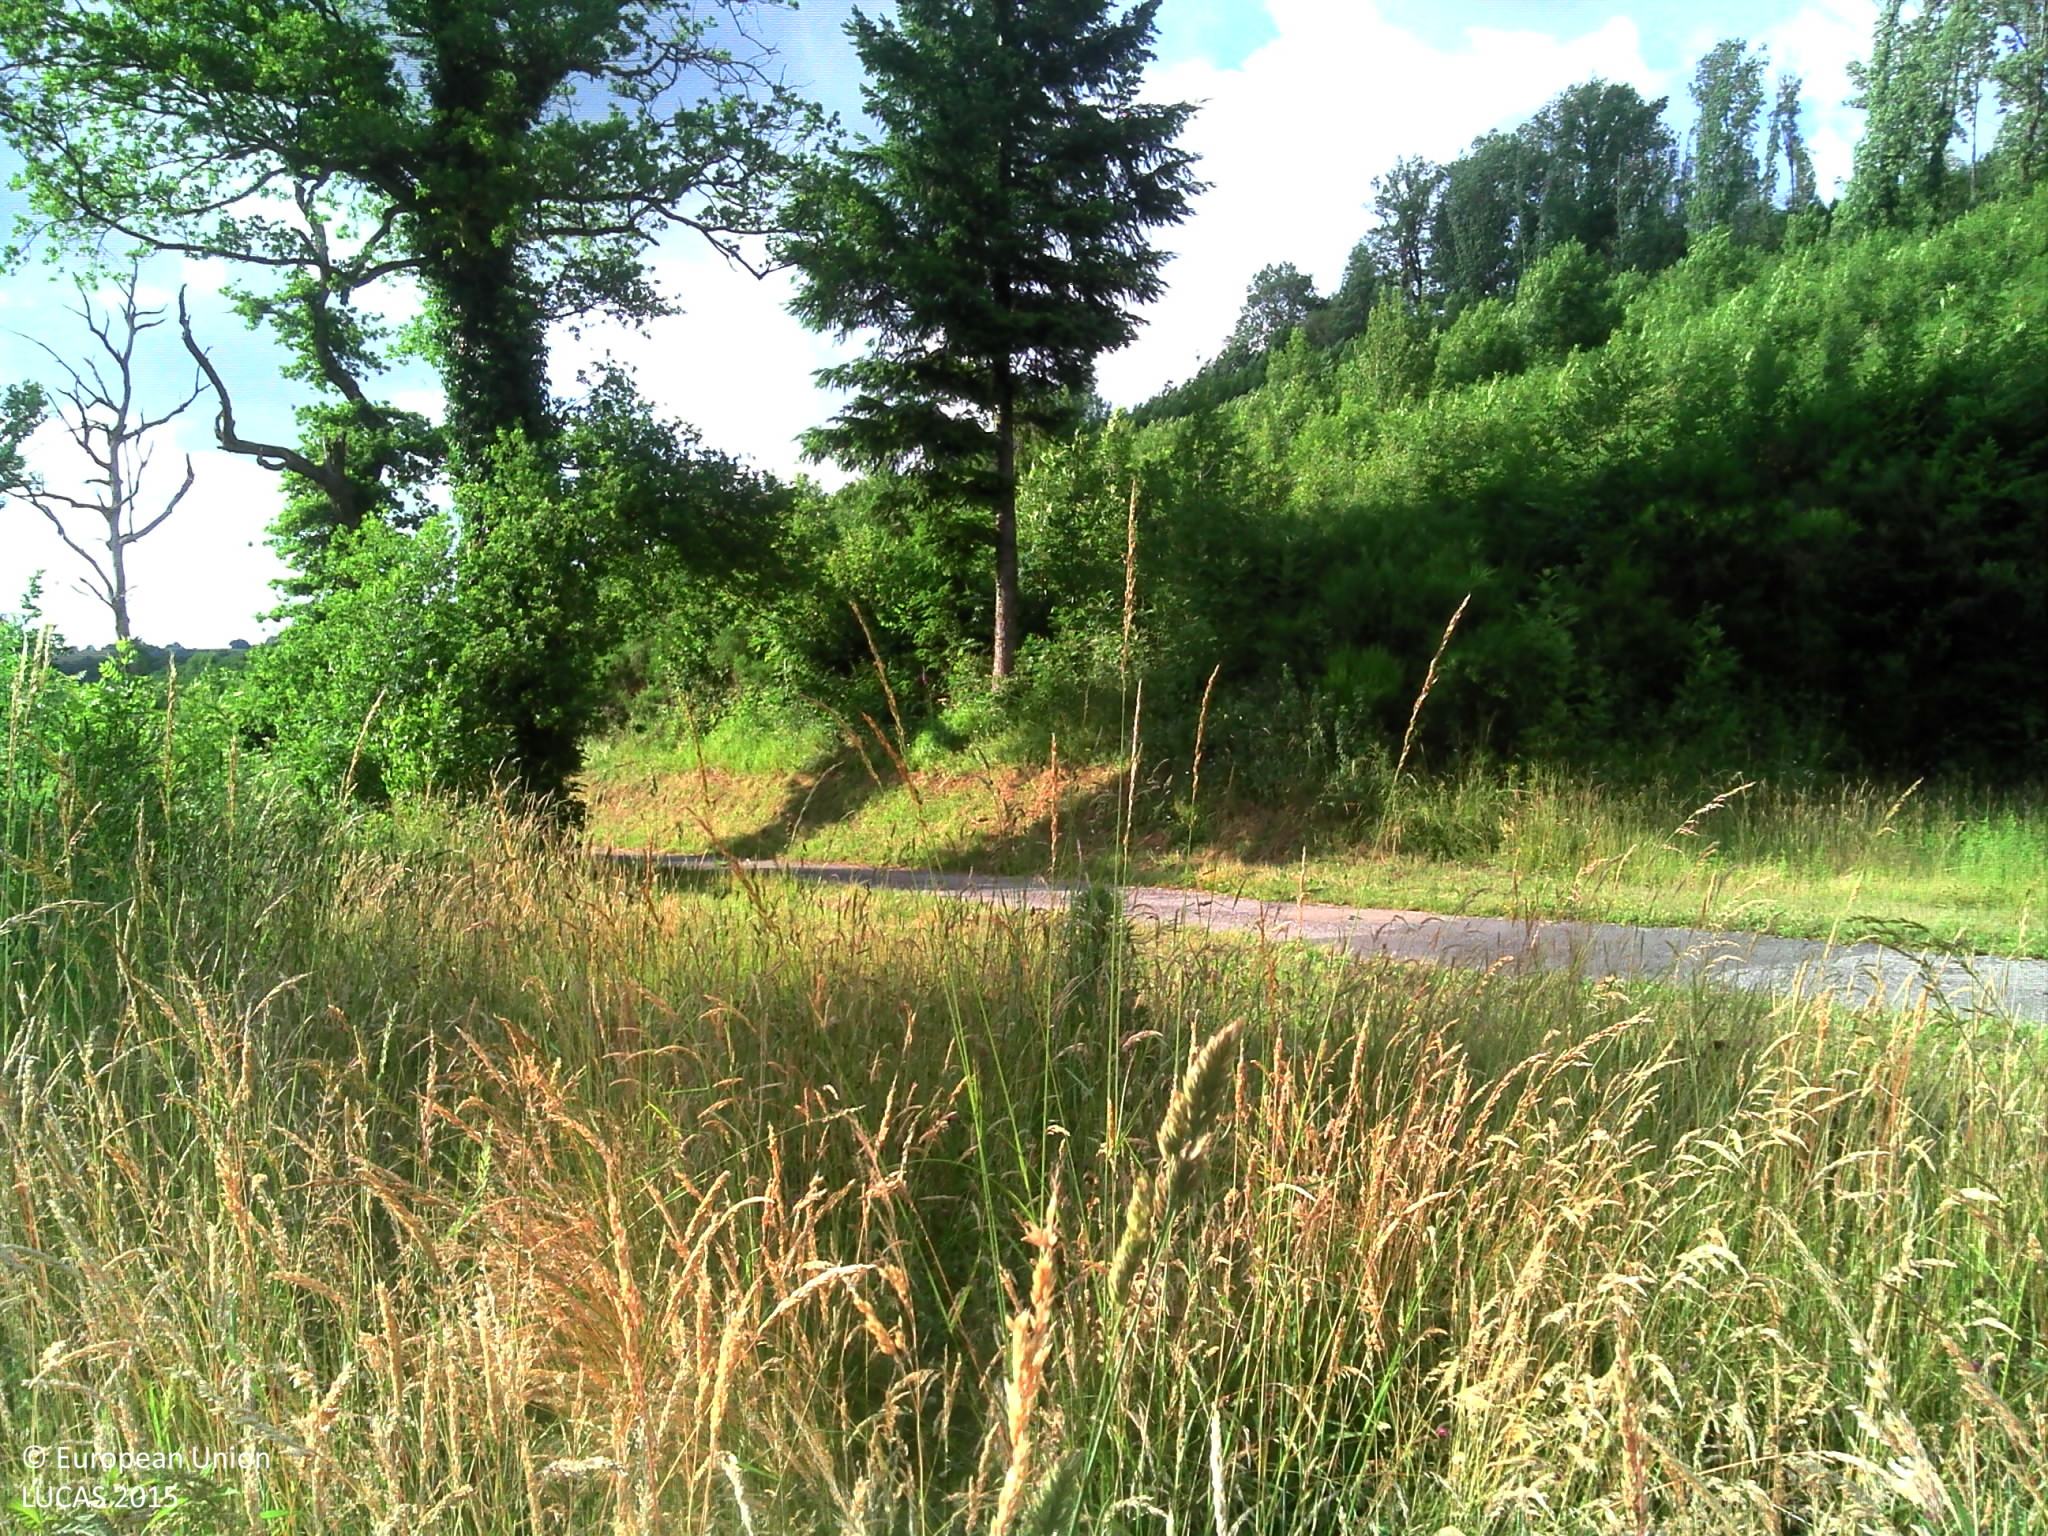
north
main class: Woodland
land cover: Spruce dominated coniferous woodland
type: exotic forest
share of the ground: > 75 %
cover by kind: coniferous forest trees 100 %
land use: Forestry
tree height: > 5 m
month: November
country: FR
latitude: 43.7936
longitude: 2.5615
